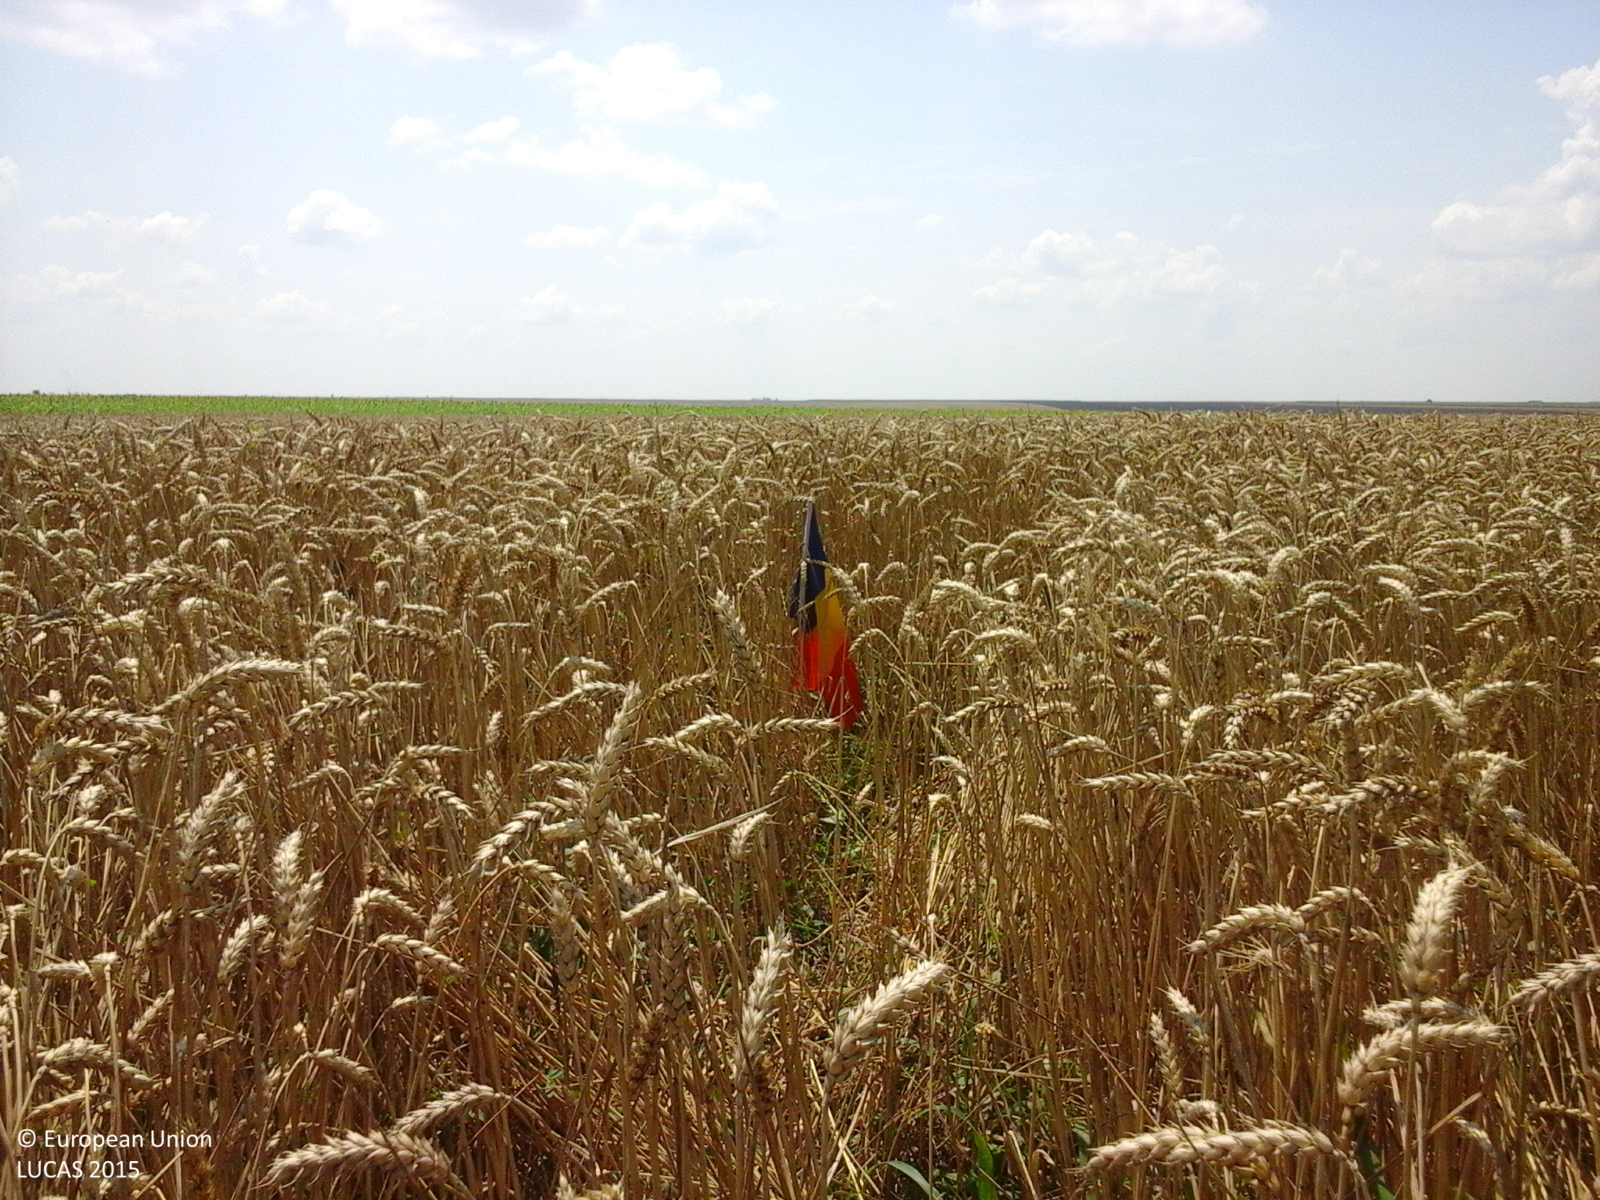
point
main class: Cropland
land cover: Common wheat
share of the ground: > 75 %
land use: Agriculture (excluding fallow land and kitchen gardens)
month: July
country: RO
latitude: 44.0006
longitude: 25.5138
